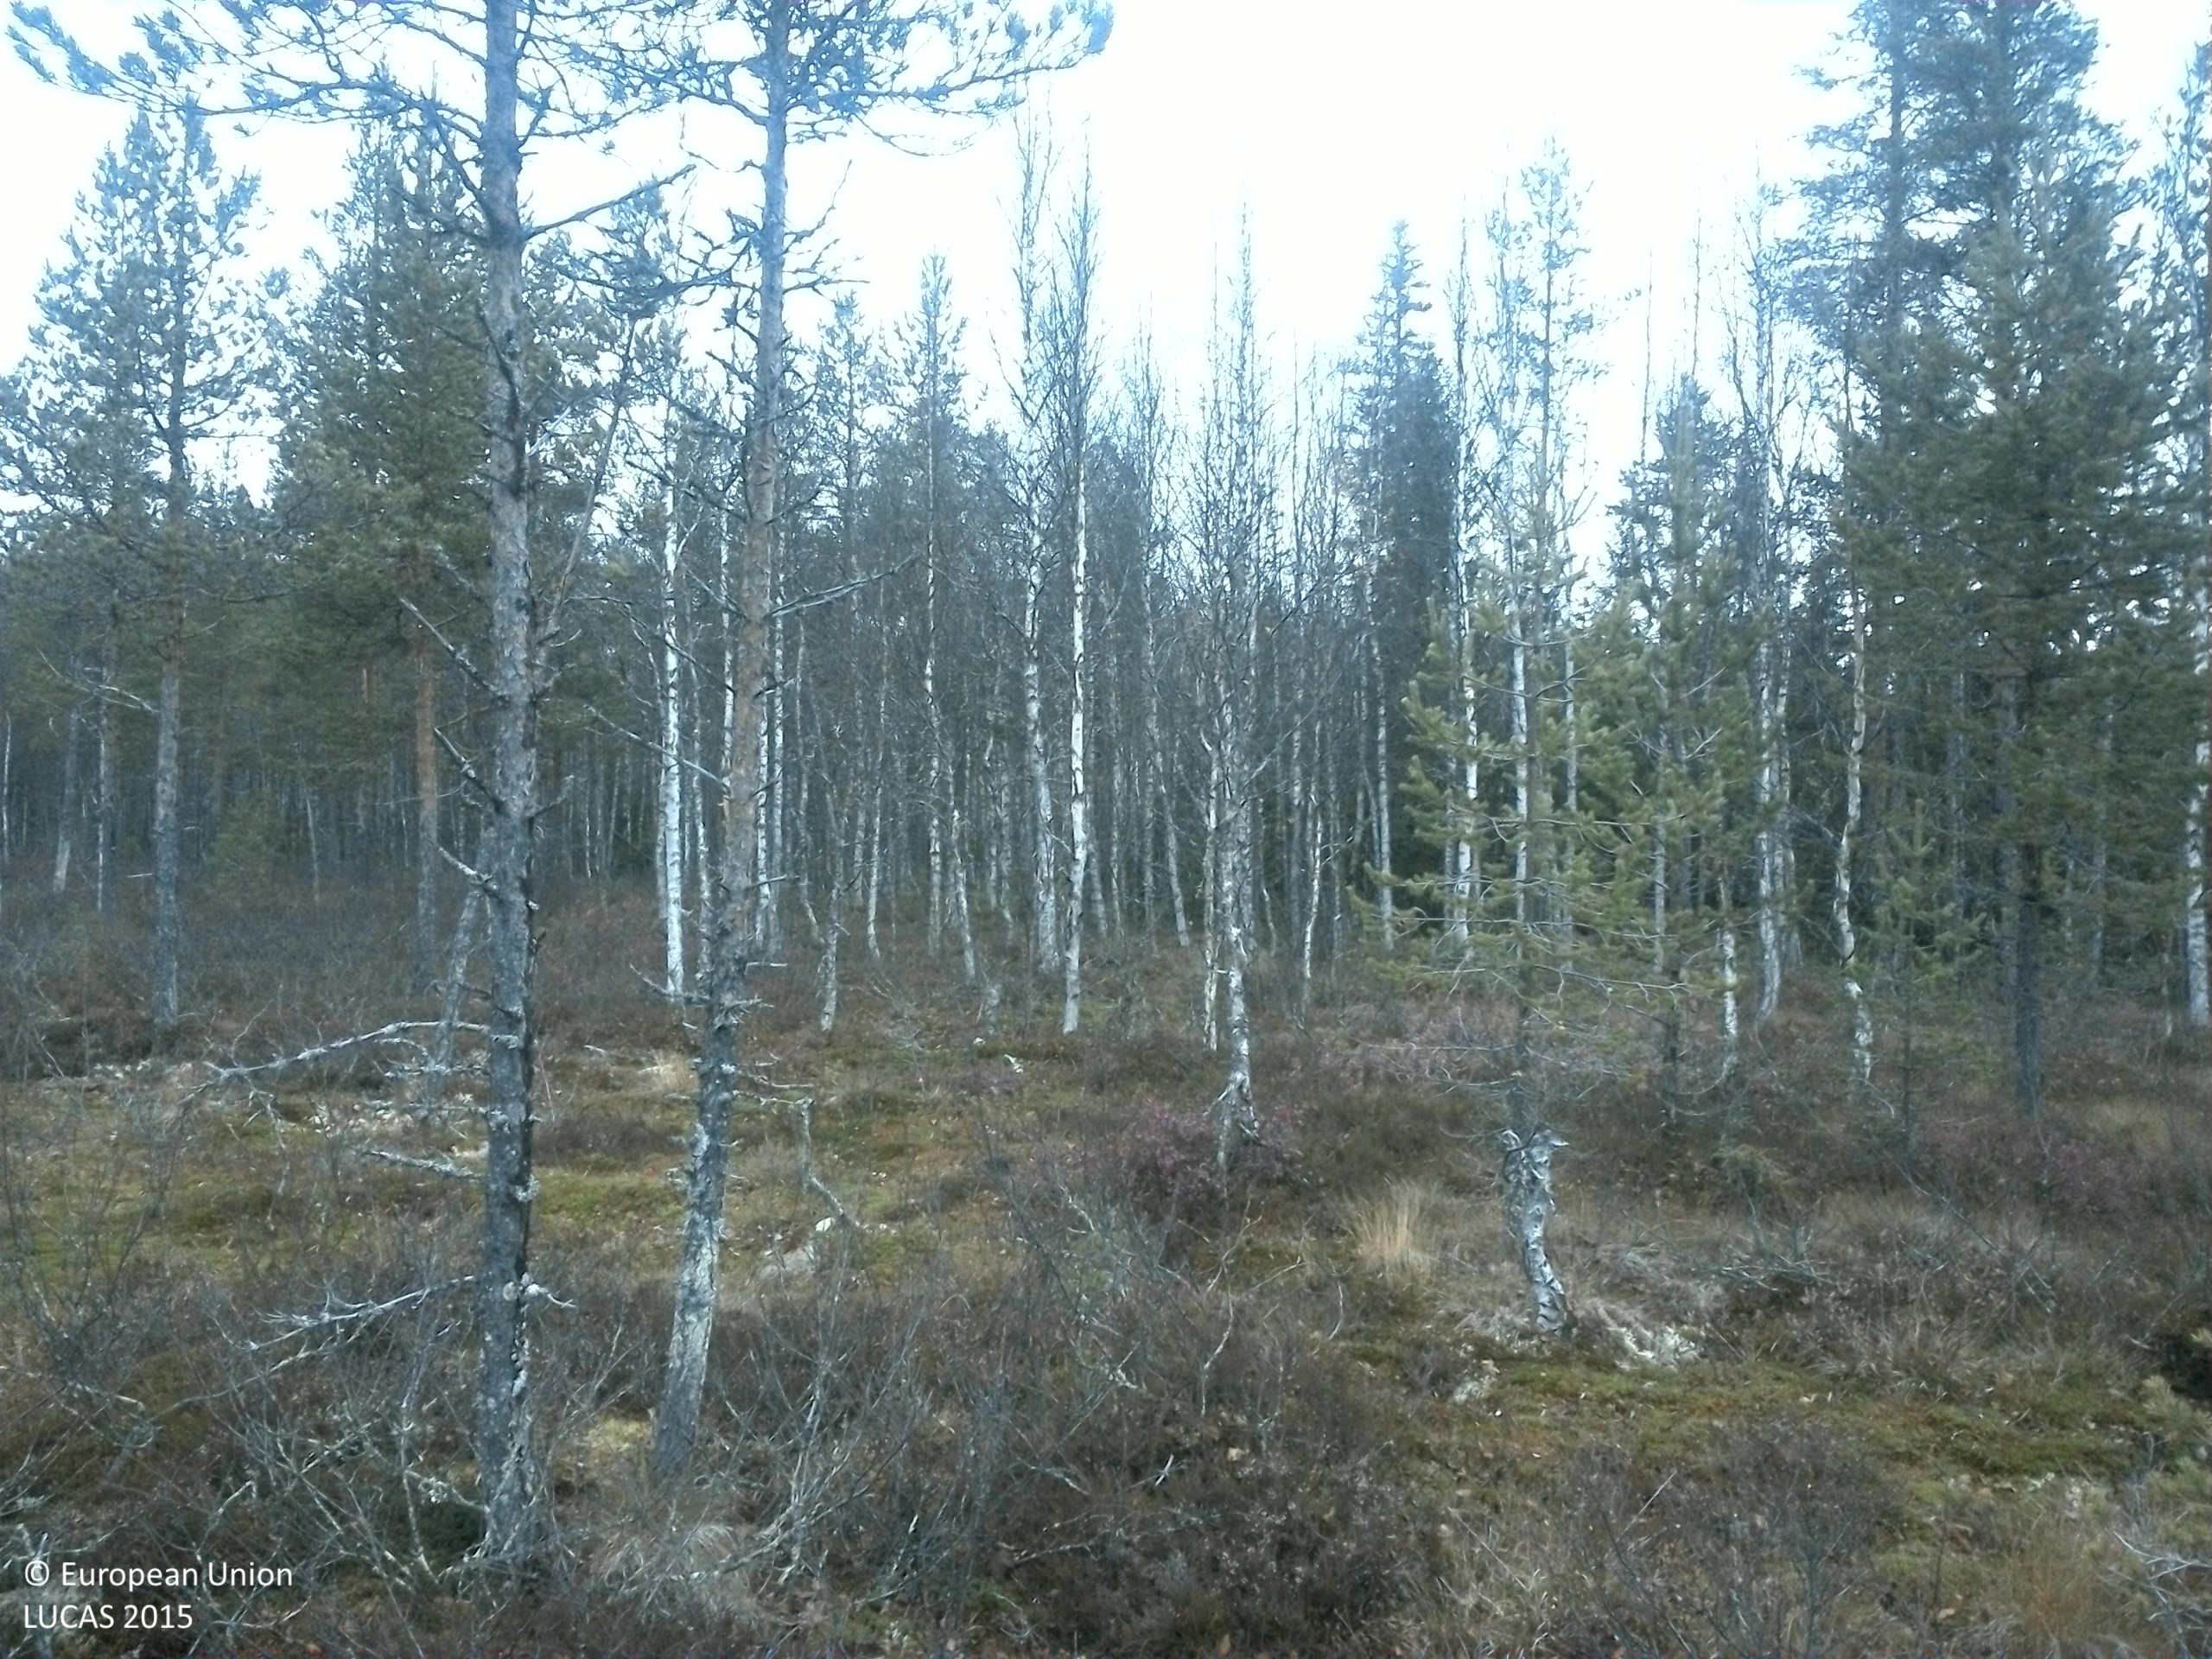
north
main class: Woodland
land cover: Pine dominated mixed woodland
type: mire and swamp forests
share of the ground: 10 - 25 %
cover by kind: shrubs 30 %, herbaceous plants 30 %, lichens and mosses 30 %, coniferous forest trees 5 %, broadleaved forest trees 5 %
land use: Semi-natural and natural areas not in use
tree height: < 5 m
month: October
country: SE
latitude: 64.0667
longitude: 16.0171
